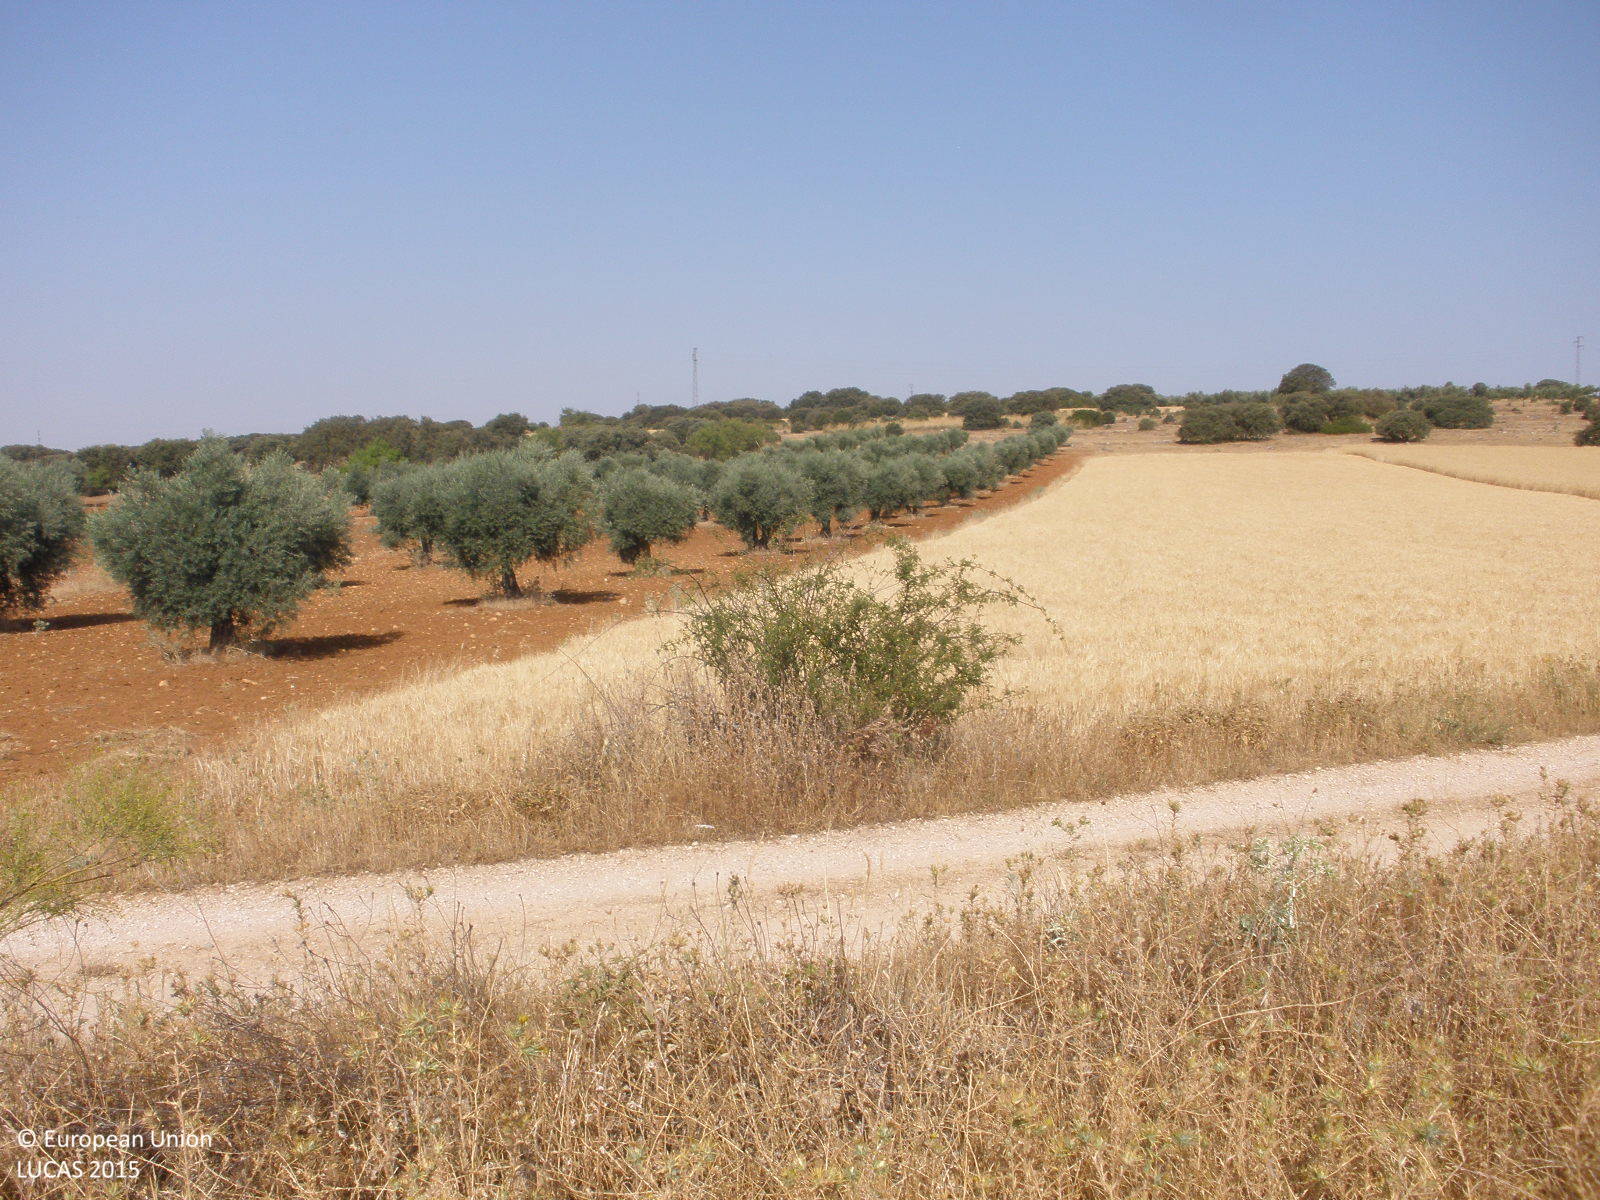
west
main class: Grassland
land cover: Spontaneously vegetated surfaces
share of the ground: > 75 %
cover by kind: herbaceous plants 100 %
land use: Fallow land
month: July
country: ES
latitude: 40.2654
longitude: -3.3539
